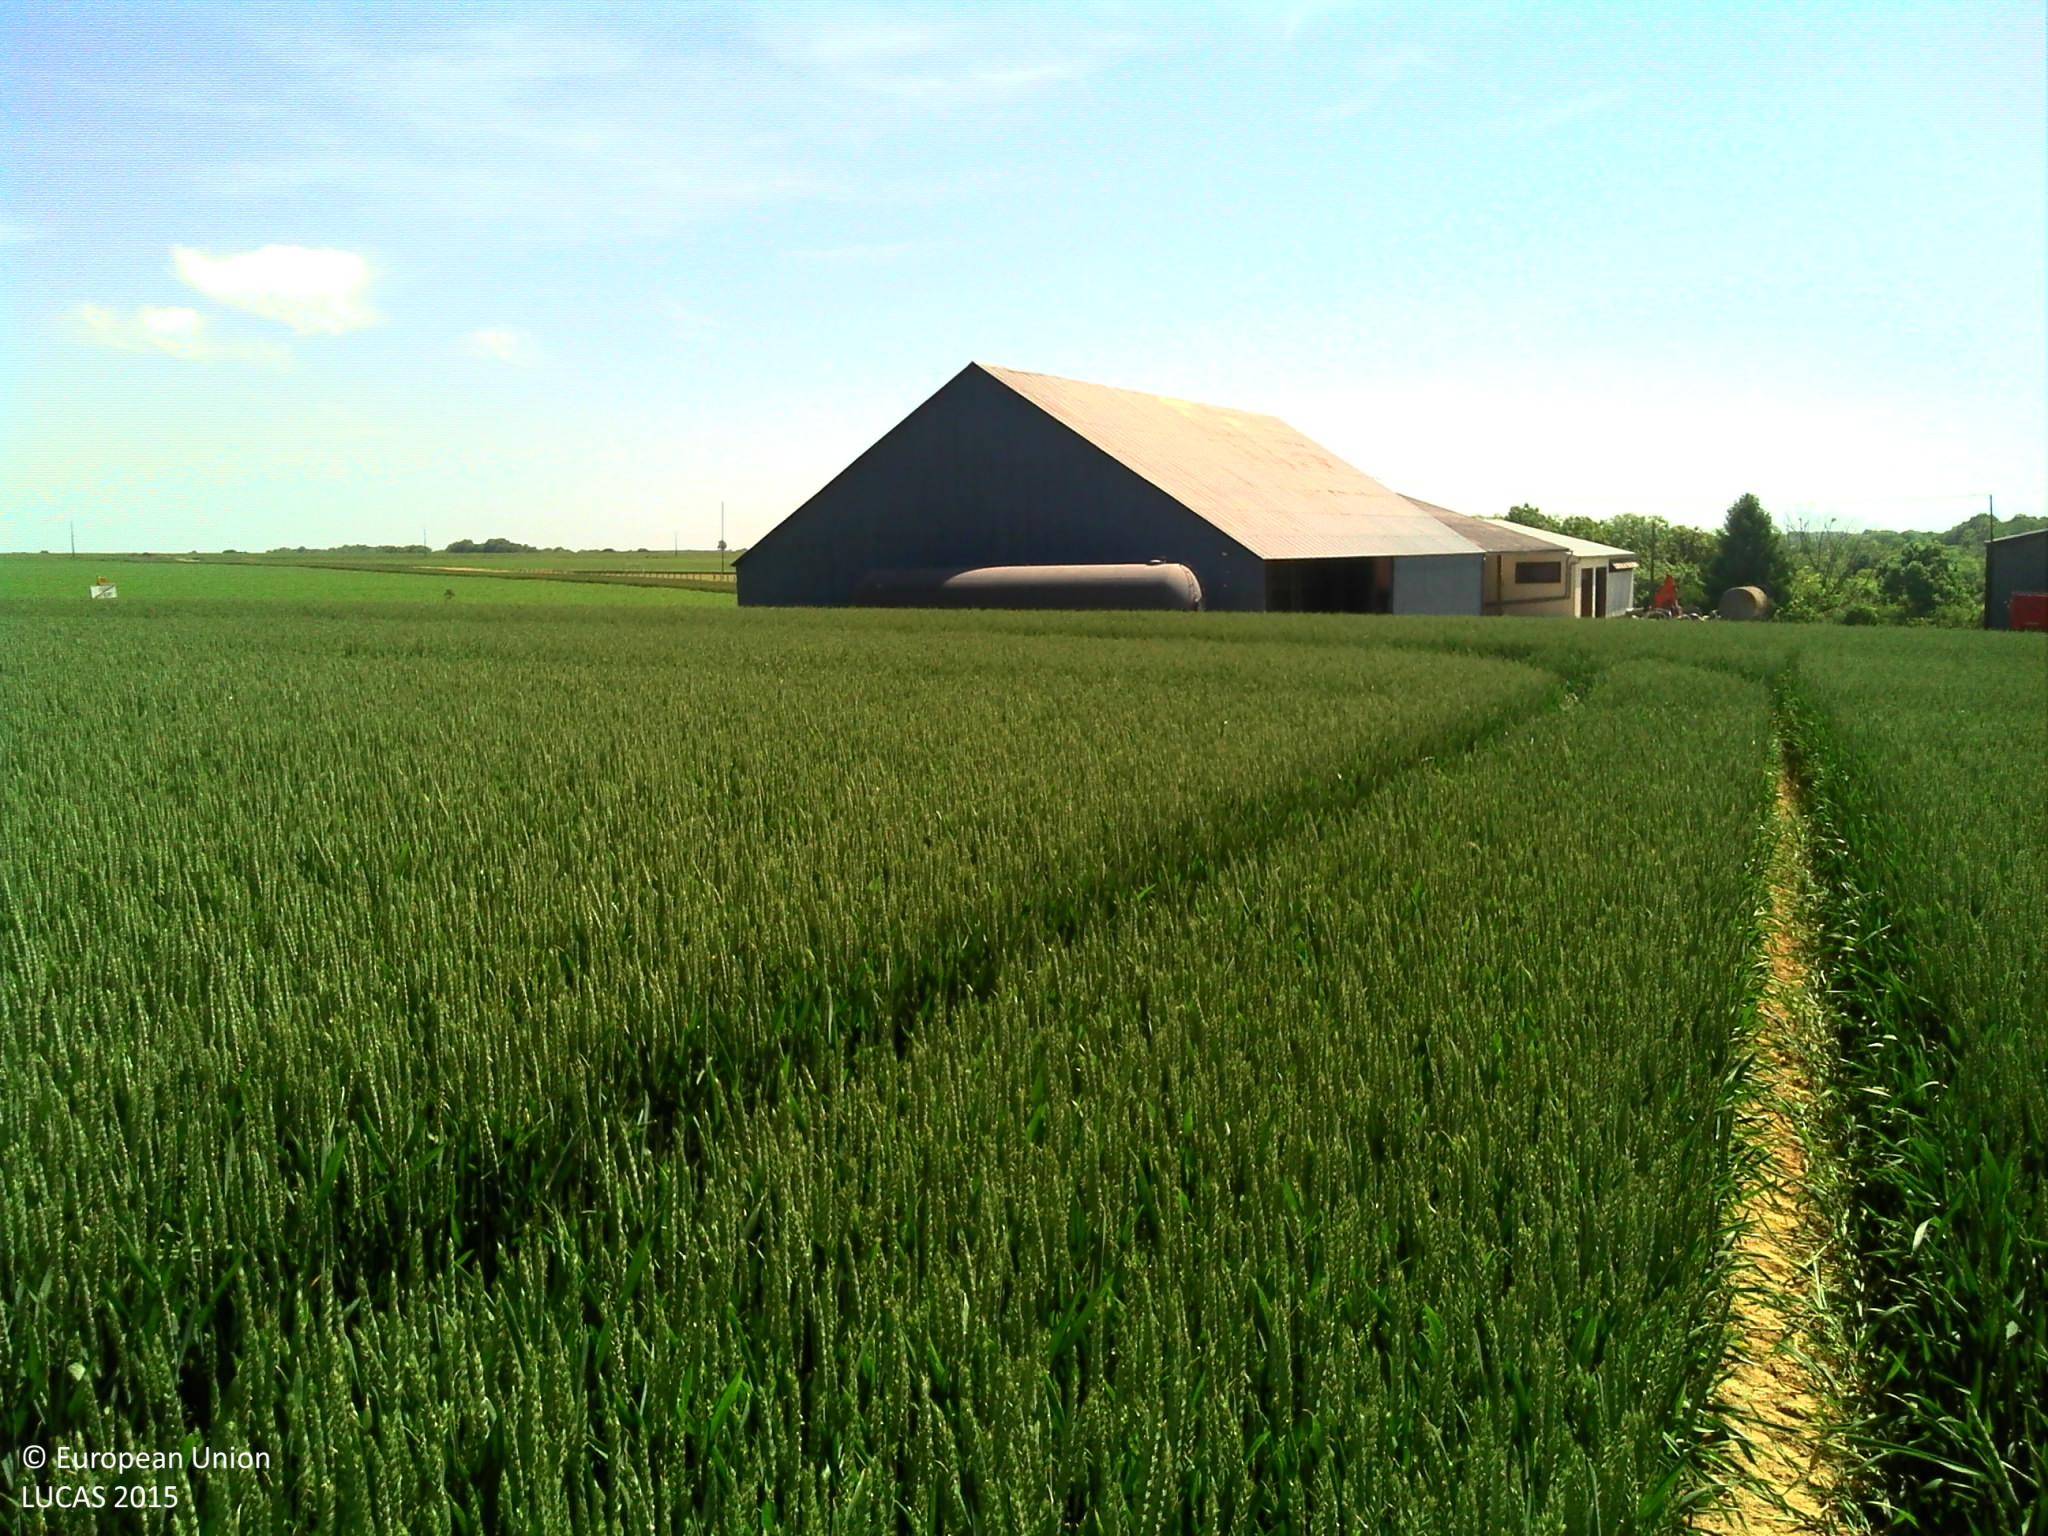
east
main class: Cropland
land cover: Common wheat
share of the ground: > 75 %
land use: Agriculture (excluding fallow land and kitchen gardens)
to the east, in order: Common wheat; Grass margins; Paved roads, cycling and walking lanes; Grassland without tree/shrub cover; Potatoes
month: June
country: FR
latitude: 49.4247
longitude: 3.2501
